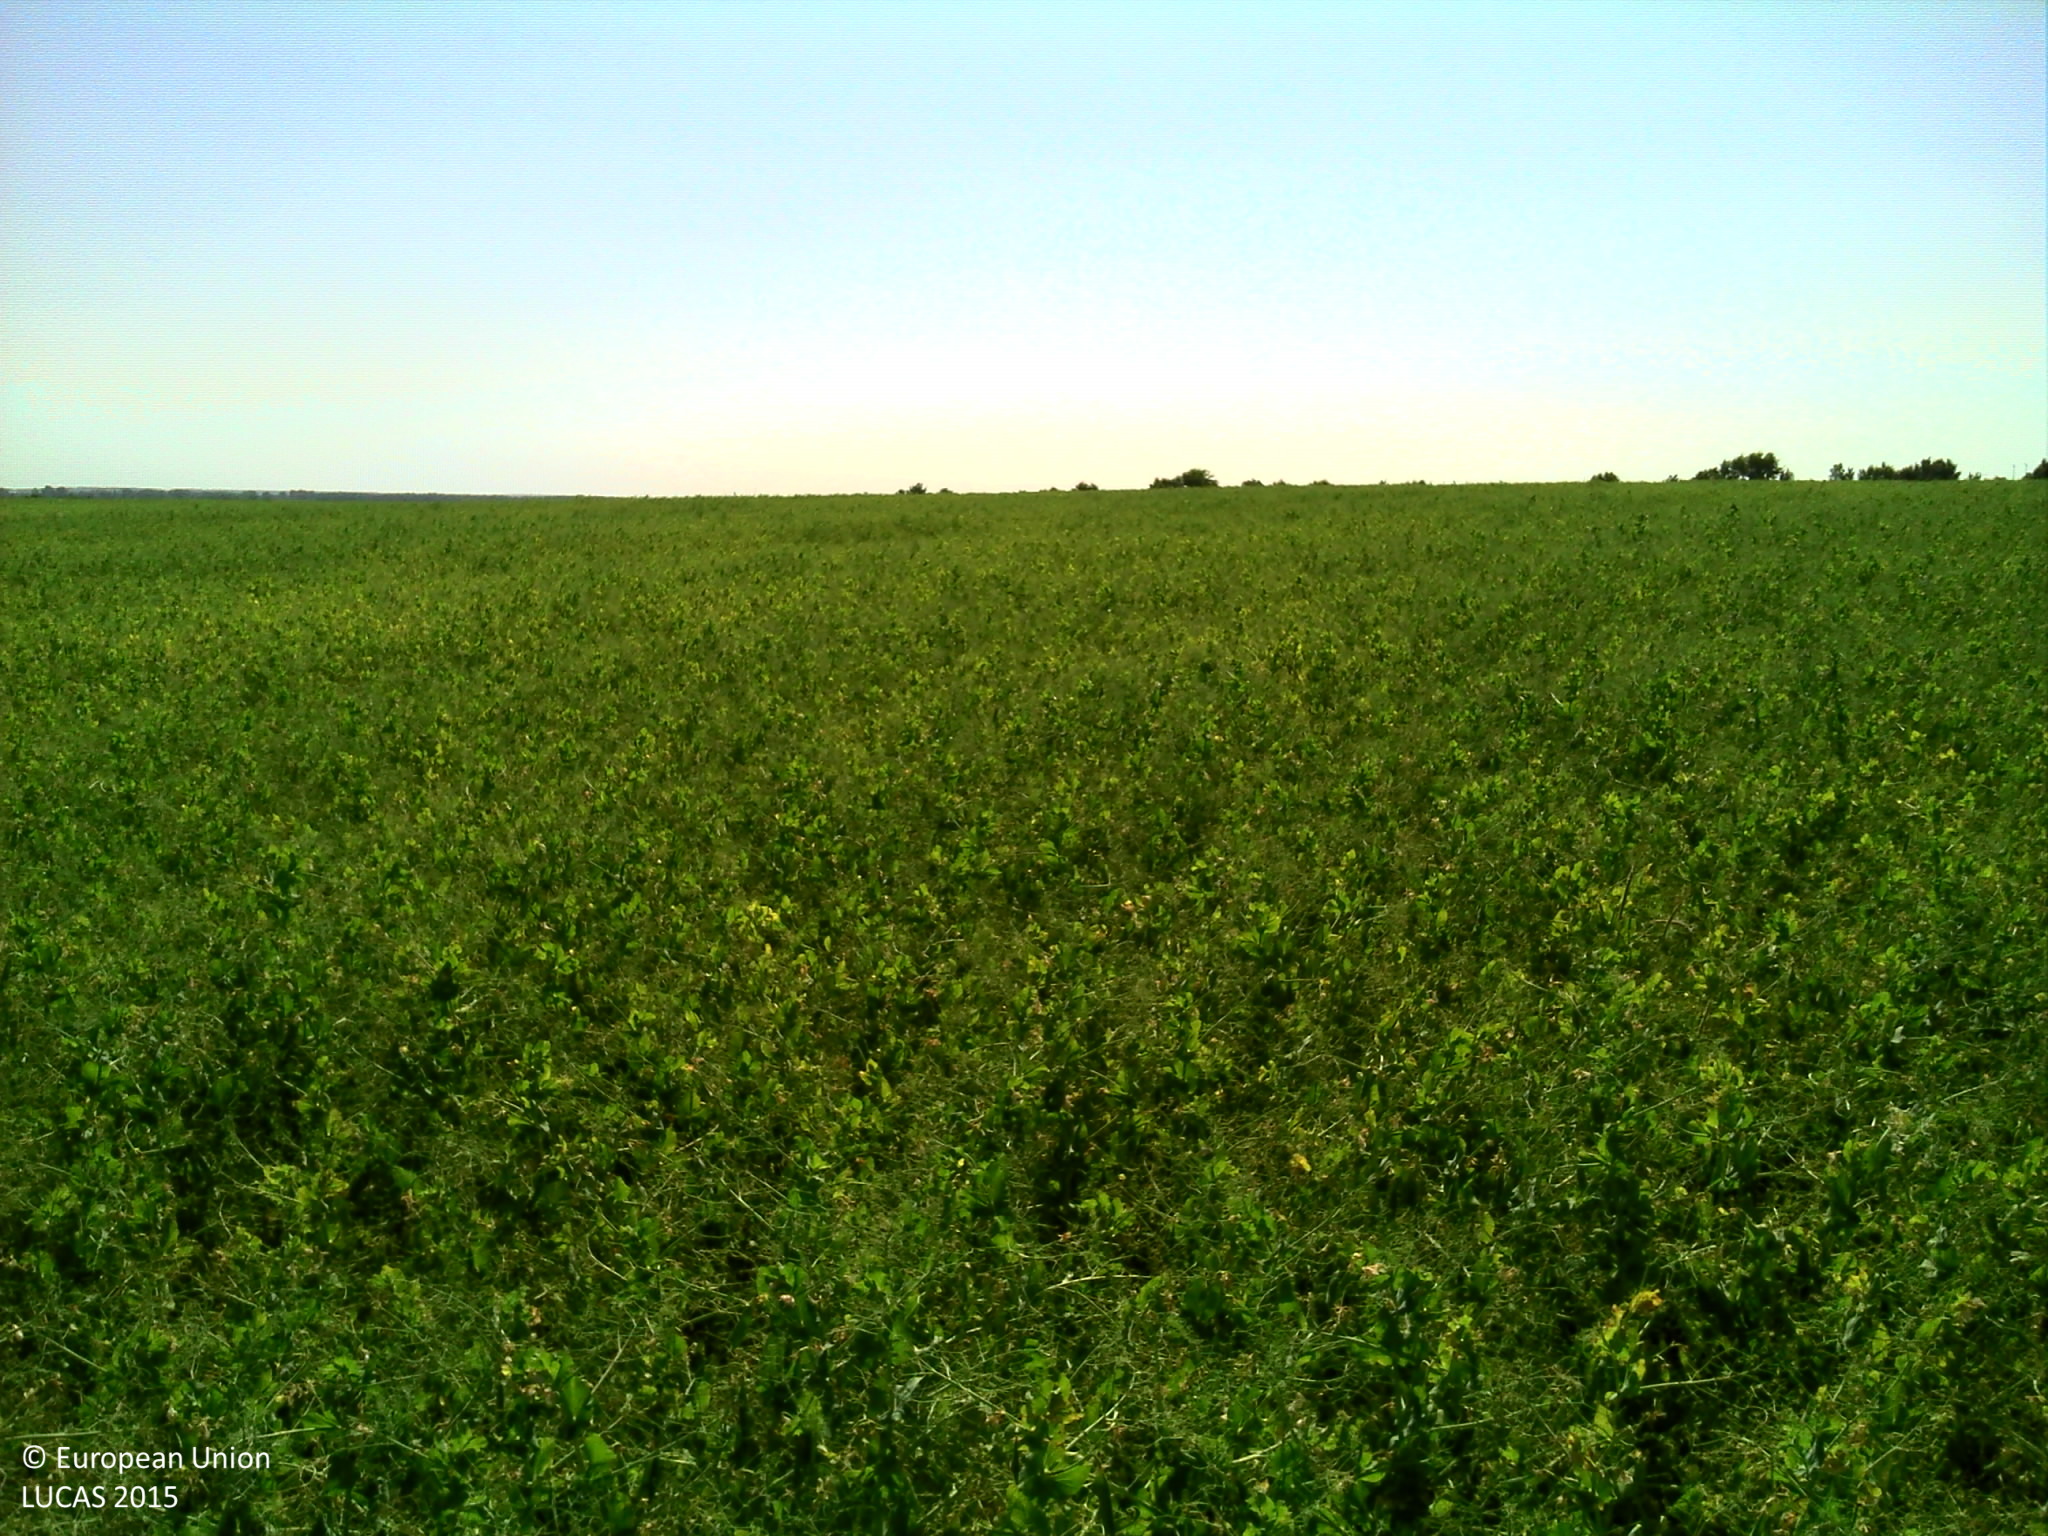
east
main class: Cropland
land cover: Dry pulses
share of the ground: > 75 %
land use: Agriculture (excluding fallow land and kitchen gardens)
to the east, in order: Dry pulses
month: June
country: FR
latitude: 46.2019
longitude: -0.9811
